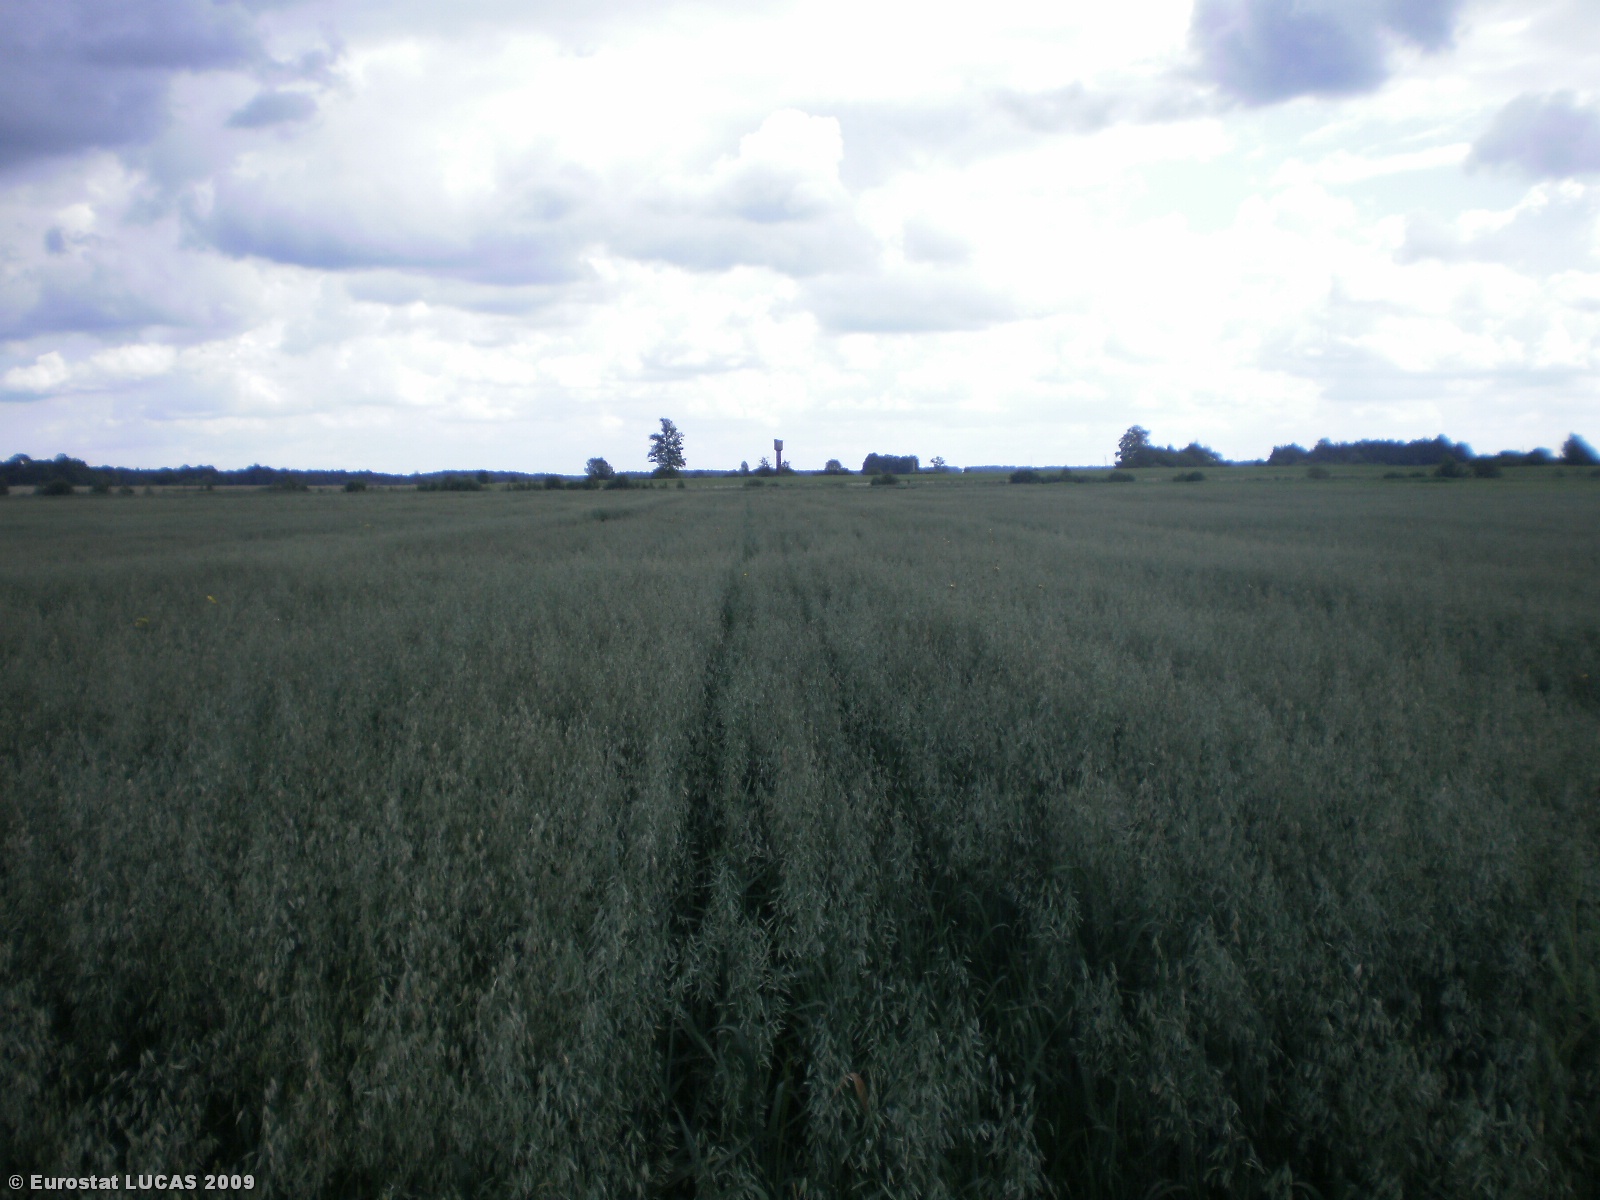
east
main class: Cropland
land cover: Oats
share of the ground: > 75 %
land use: Agriculture (excluding fallow land and kitchen gardens)
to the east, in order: Oats
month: July
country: LT
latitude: 56.0885
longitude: 25.1398
